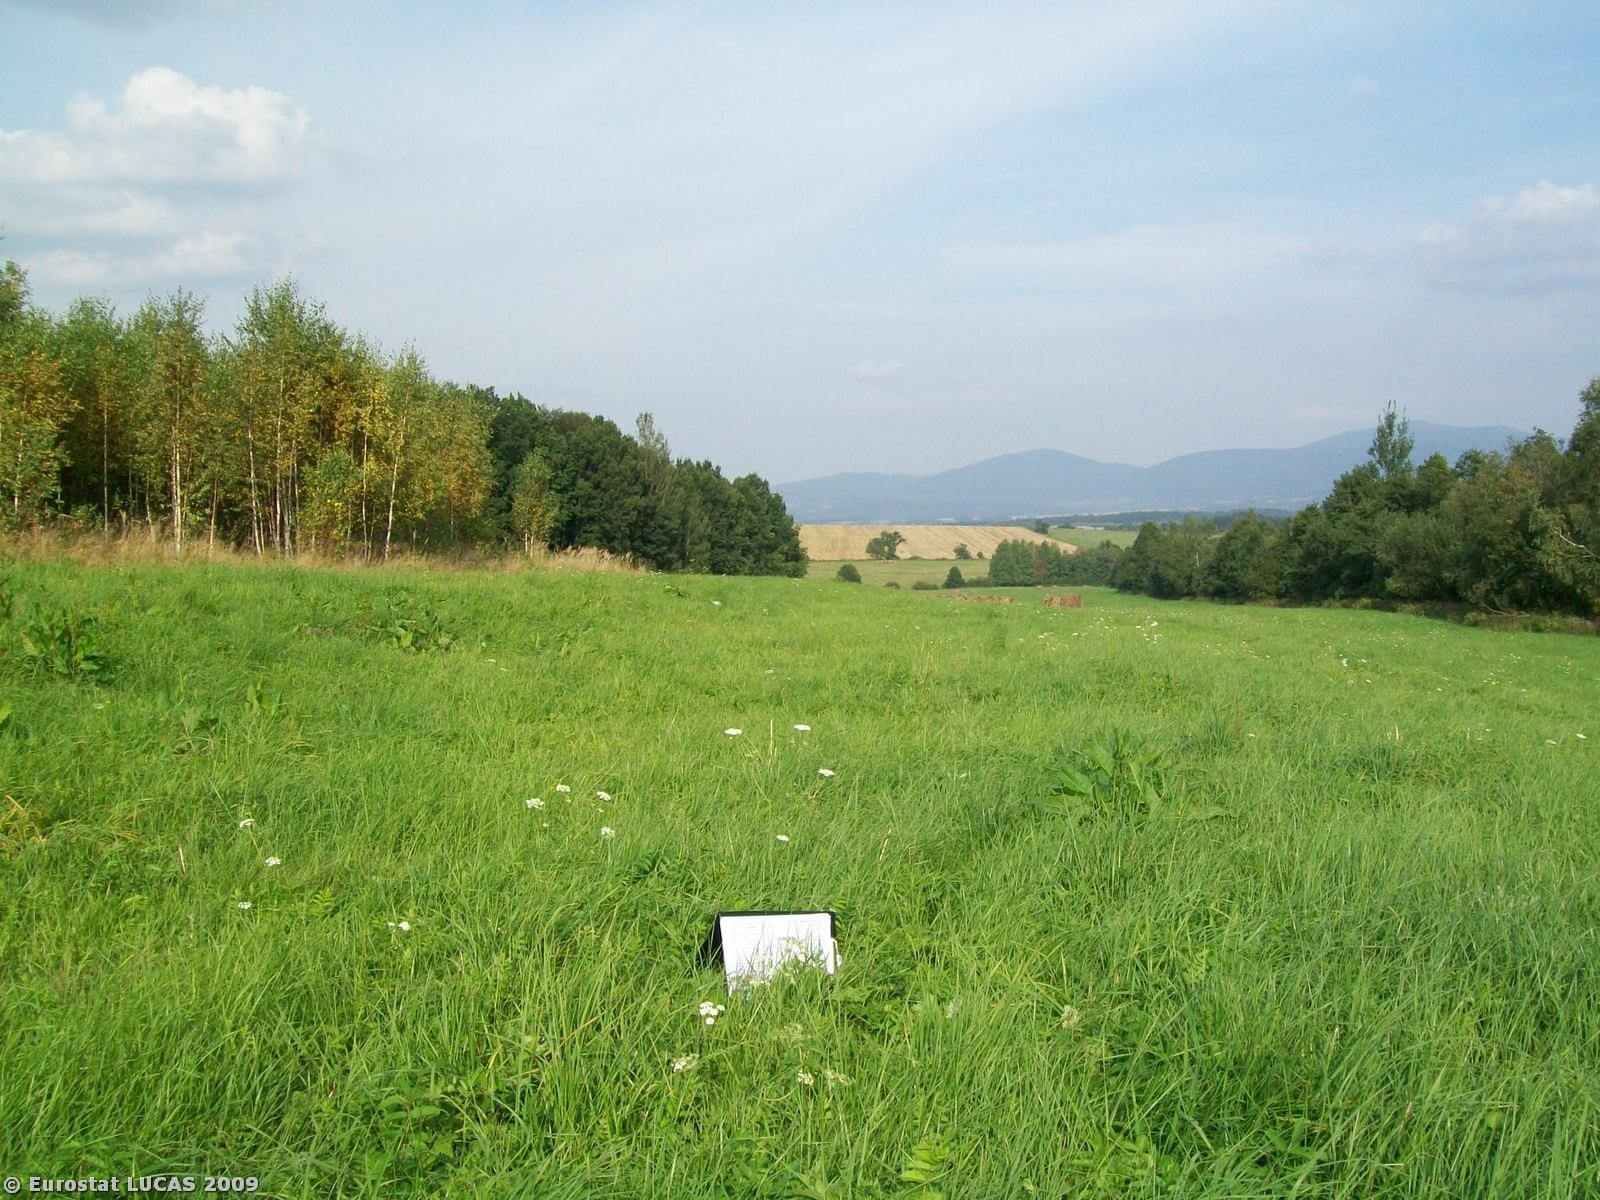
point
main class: Grassland
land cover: Grassland without tree/shrub cover
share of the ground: > 75 %
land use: Agriculture (excluding fallow land and kitchen gardens)
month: September
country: PL
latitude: 50.2269
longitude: 16.6103
